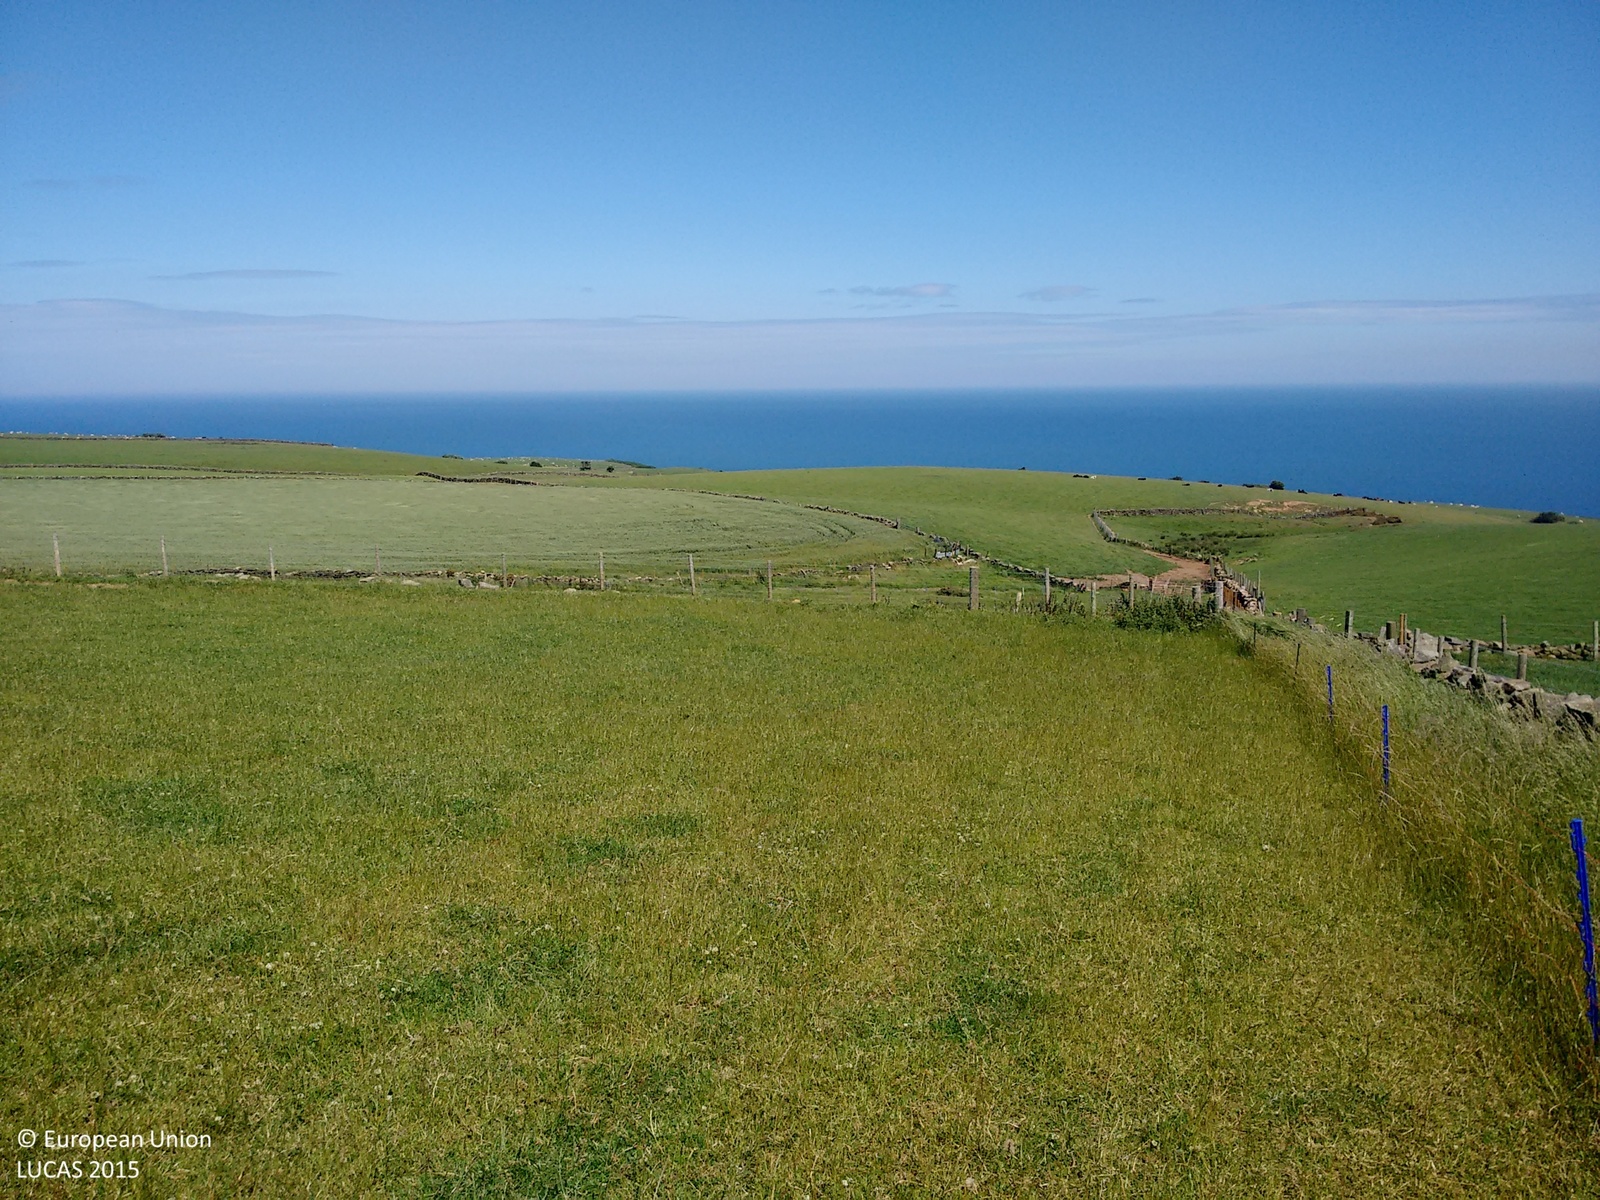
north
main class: Grassland
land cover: Grassland without tree/shrub cover
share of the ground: > 75 %
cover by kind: herbaceous plants 100 %
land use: Agriculture (excluding fallow land and kitchen gardens)
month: June
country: GB
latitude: 54.4463
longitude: -0.5380
